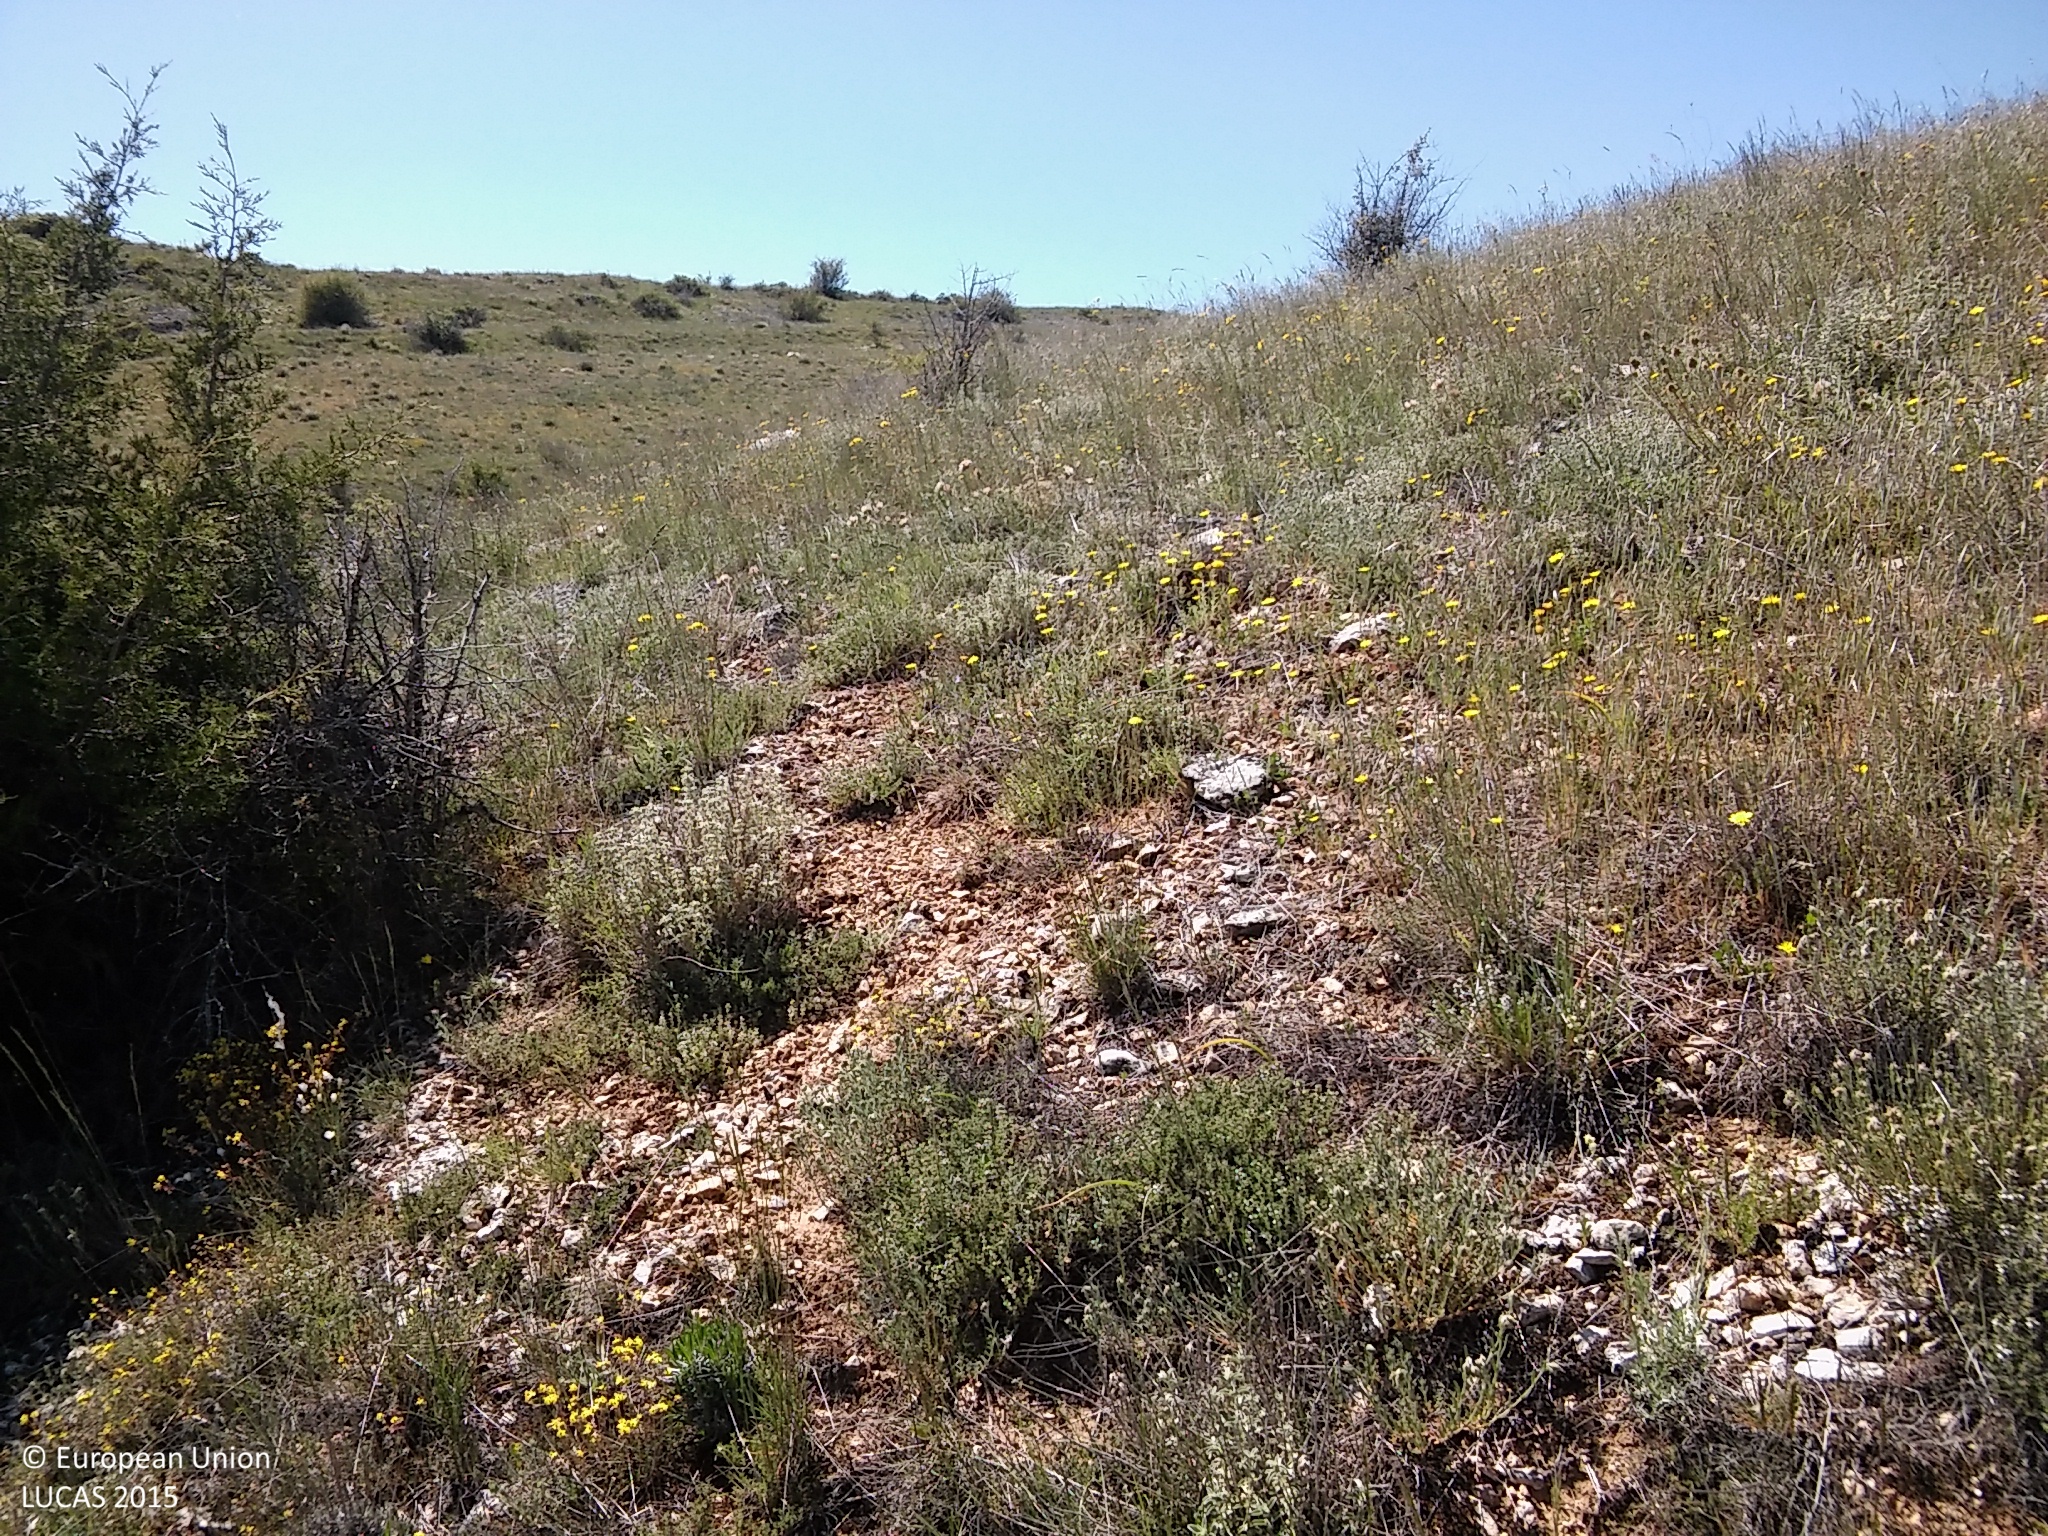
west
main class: Shrubland
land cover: Shrubland without tree cover
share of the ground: 25 - 50 %
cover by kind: shrubs 40 %, unconsolidated bare surface 35 %, consolidated bare surface 15 %, herbaceous plants 10 %
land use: Agriculture (excluding fallow land and kitchen gardens)
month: May
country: ES
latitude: 41.4185
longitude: -3.7500
